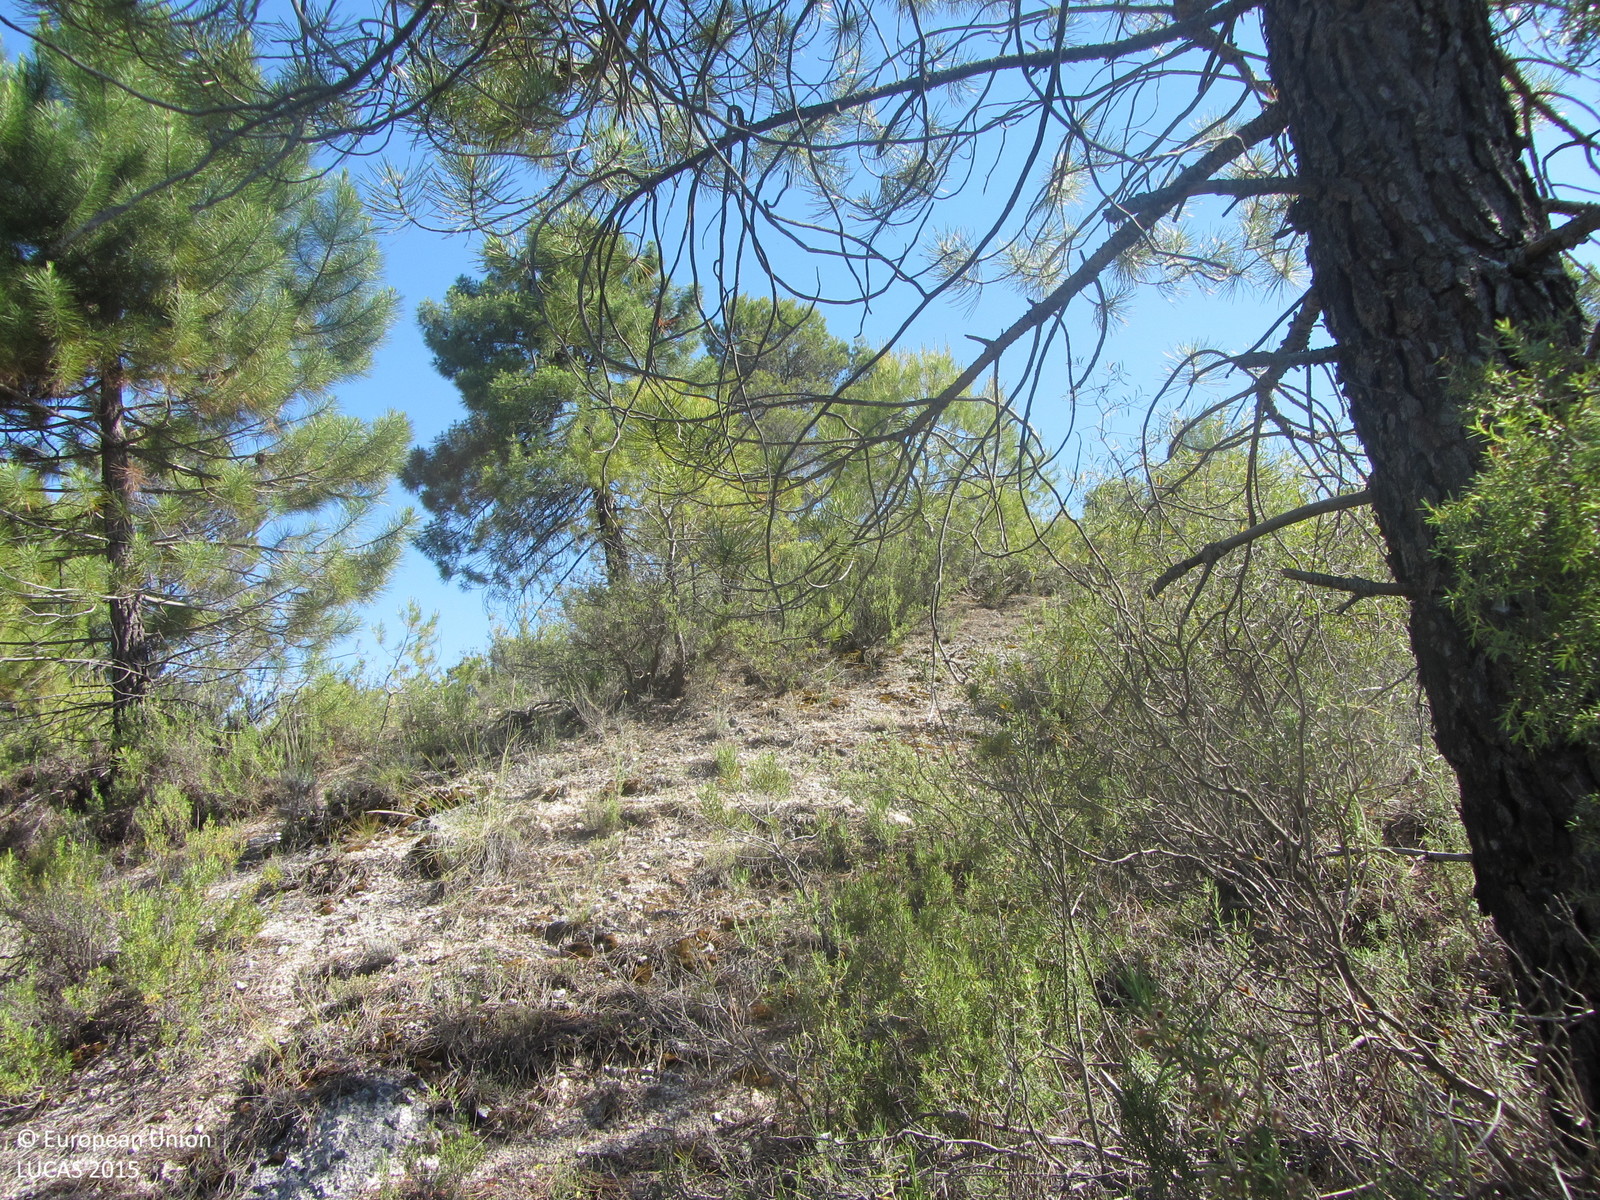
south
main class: Woodland
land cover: Pine dominated coniferous woodland
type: coniferous forest of the mediterranean region
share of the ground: 25 - 50 %
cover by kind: coniferous forest trees 35 %, shrubs 35 %, unconsolidated bare surface 20 %, herbaceous plants 10 %
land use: Forestry
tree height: > 5 m
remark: Clear cut
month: June
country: ES
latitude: 38.4104
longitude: -2.5845
